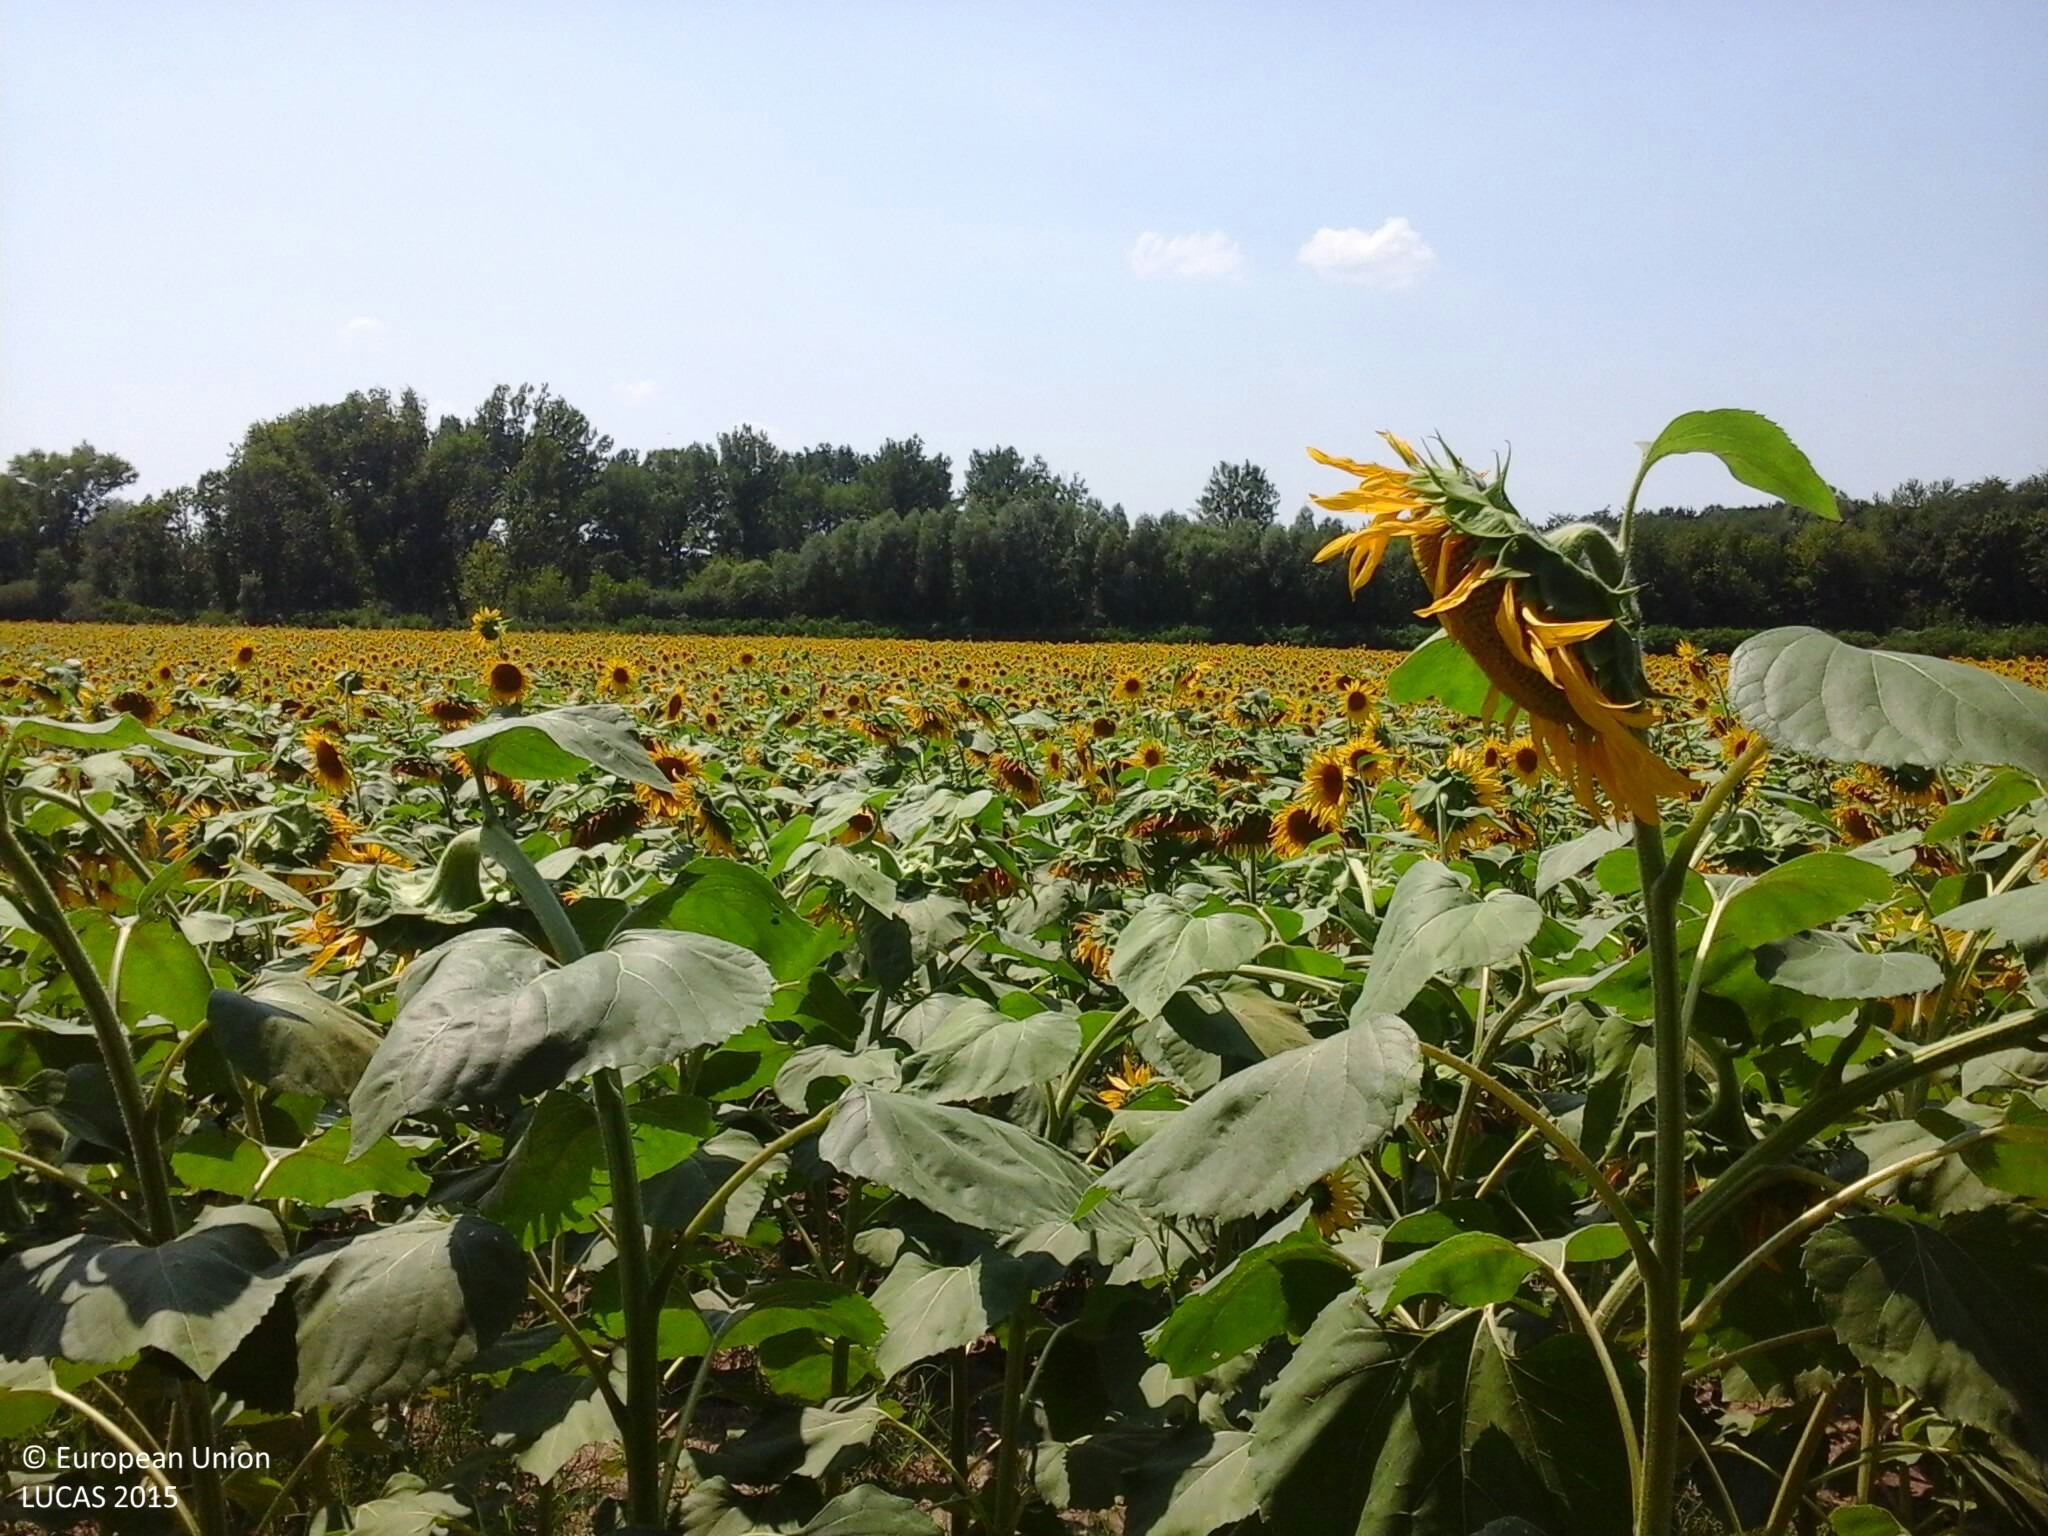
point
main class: Cropland
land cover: Sunflower
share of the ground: > 75 %
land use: Agriculture (excluding fallow land and kitchen gardens)
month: July
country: HU
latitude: 46.6523
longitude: 17.1777
